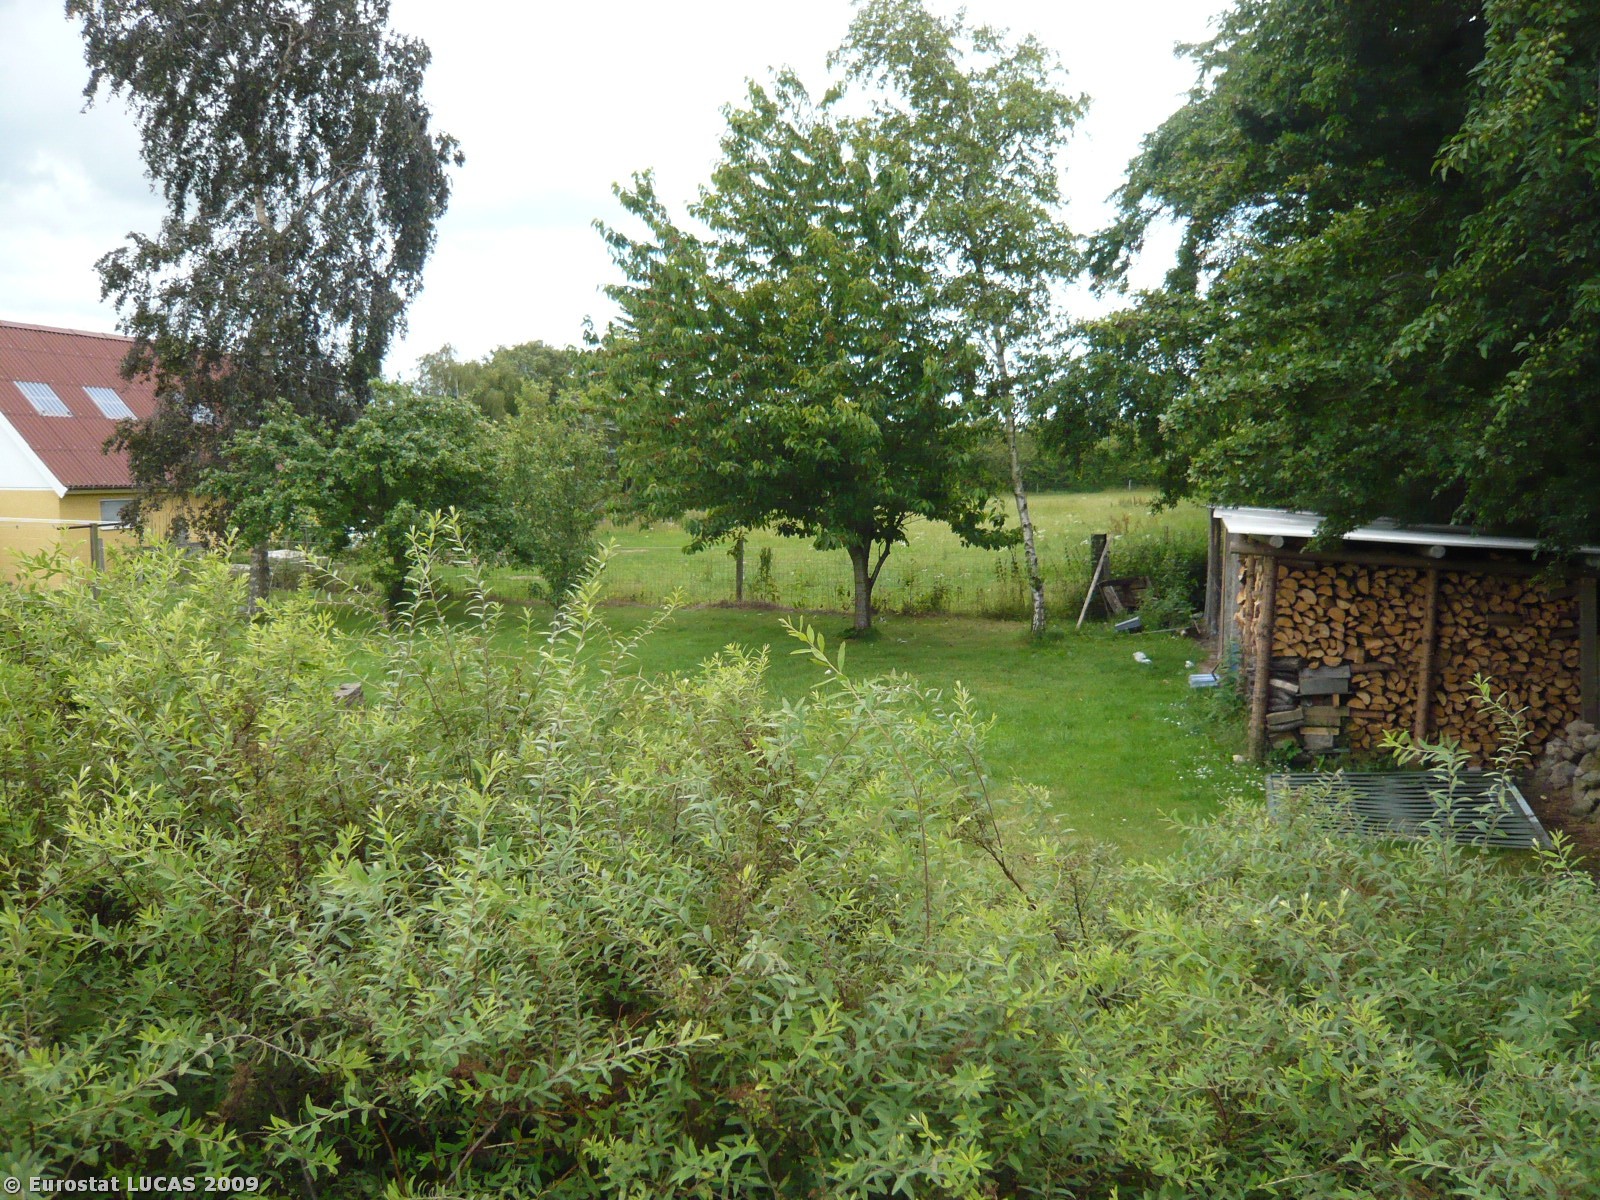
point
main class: Grassland
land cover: Grassland without tree/shrub cover
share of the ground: > 75 %
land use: Agriculture (excluding fallow land and kitchen gardens)
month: July
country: DK
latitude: 55.4763
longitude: 11.6282
